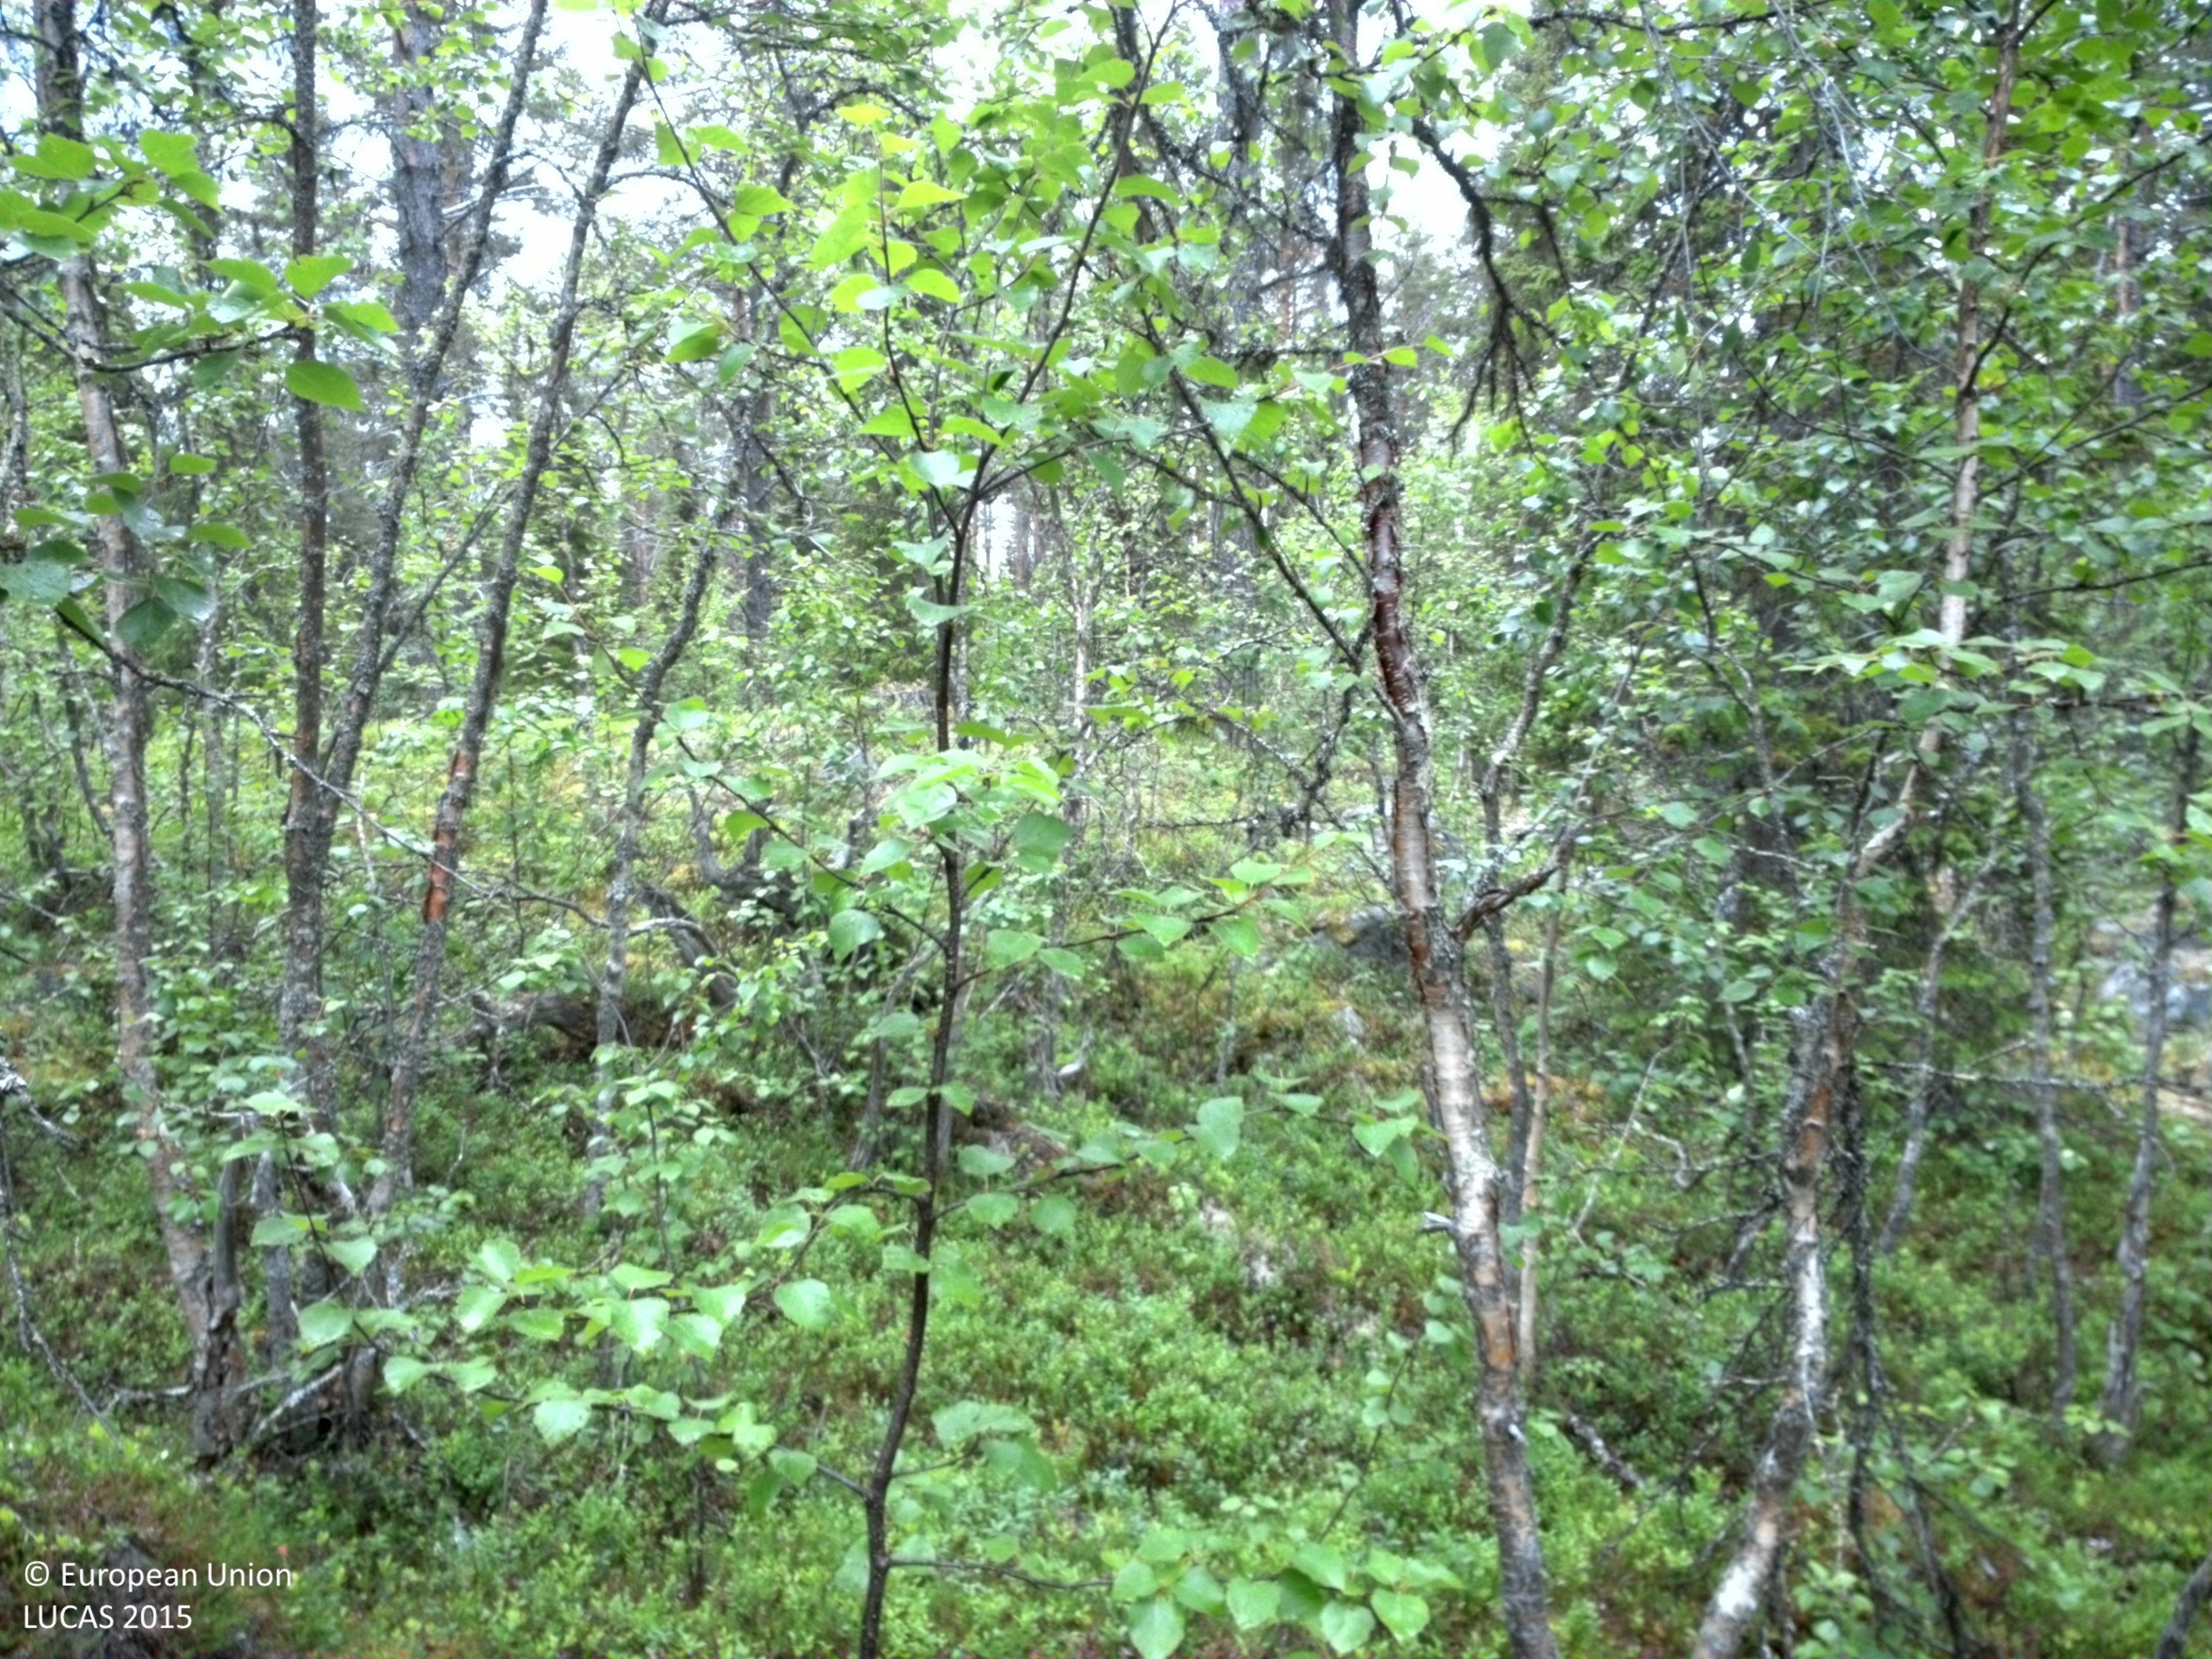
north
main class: Woodland
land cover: Pine dominated mixed woodland
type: boreal forest
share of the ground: 25 - 50 %
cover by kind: shrubs 40 %, broadleaved forest trees 25 %, lichens and mosses 20 %, coniferous forest trees 15 %
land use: Forestry
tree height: > 5 m
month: August
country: SE
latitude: 65.0403
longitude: 16.1457
